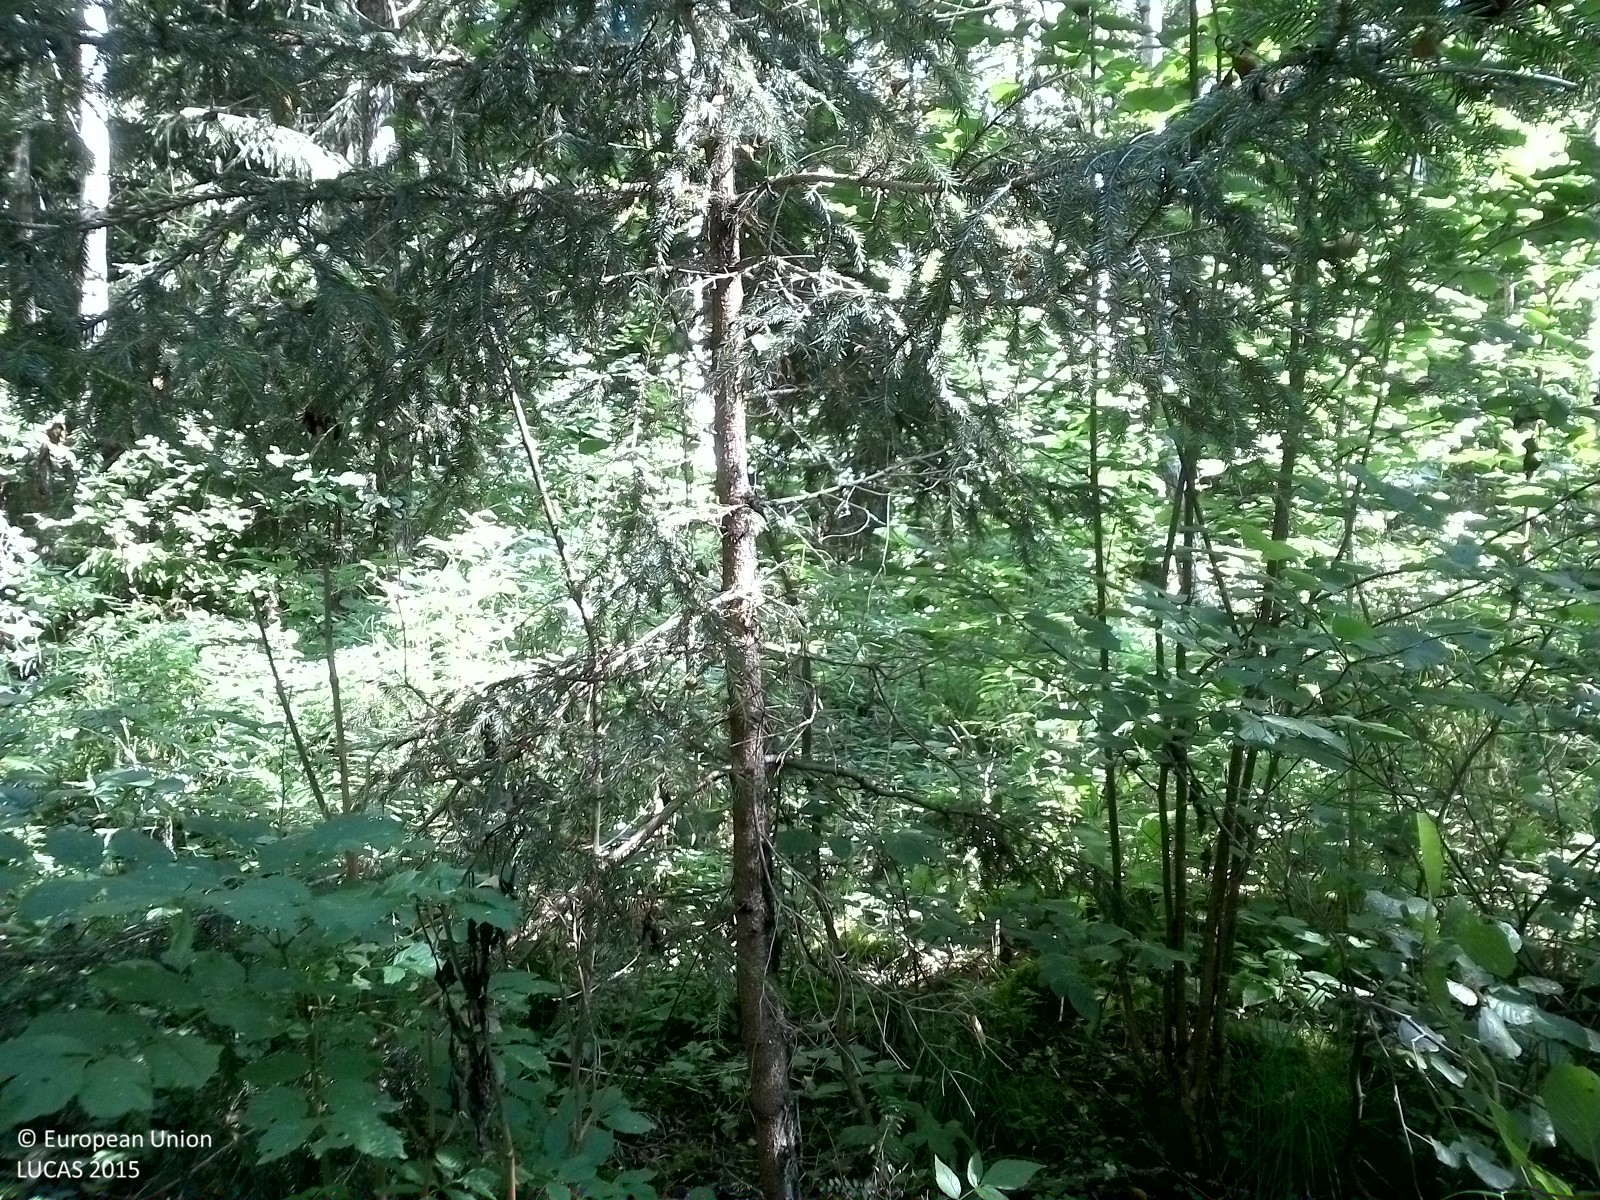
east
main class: Woodland
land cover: Spruce dominated mixed woodland
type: boreal forest
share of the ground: 50 - 75 %
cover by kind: coniferous forest trees 30 %, broadleaved forest trees 25 %, herbaceous plants 20 %, shrubs 15 %, unconsolidated bare surface 10 %
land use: Forestry
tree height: > 5 m
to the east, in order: Spruce dominated mixed woodland; Tracks; Spruce dominated mixed woodland; Broadleaved woodland
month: August
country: SE
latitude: 59.2579
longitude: 15.5868
